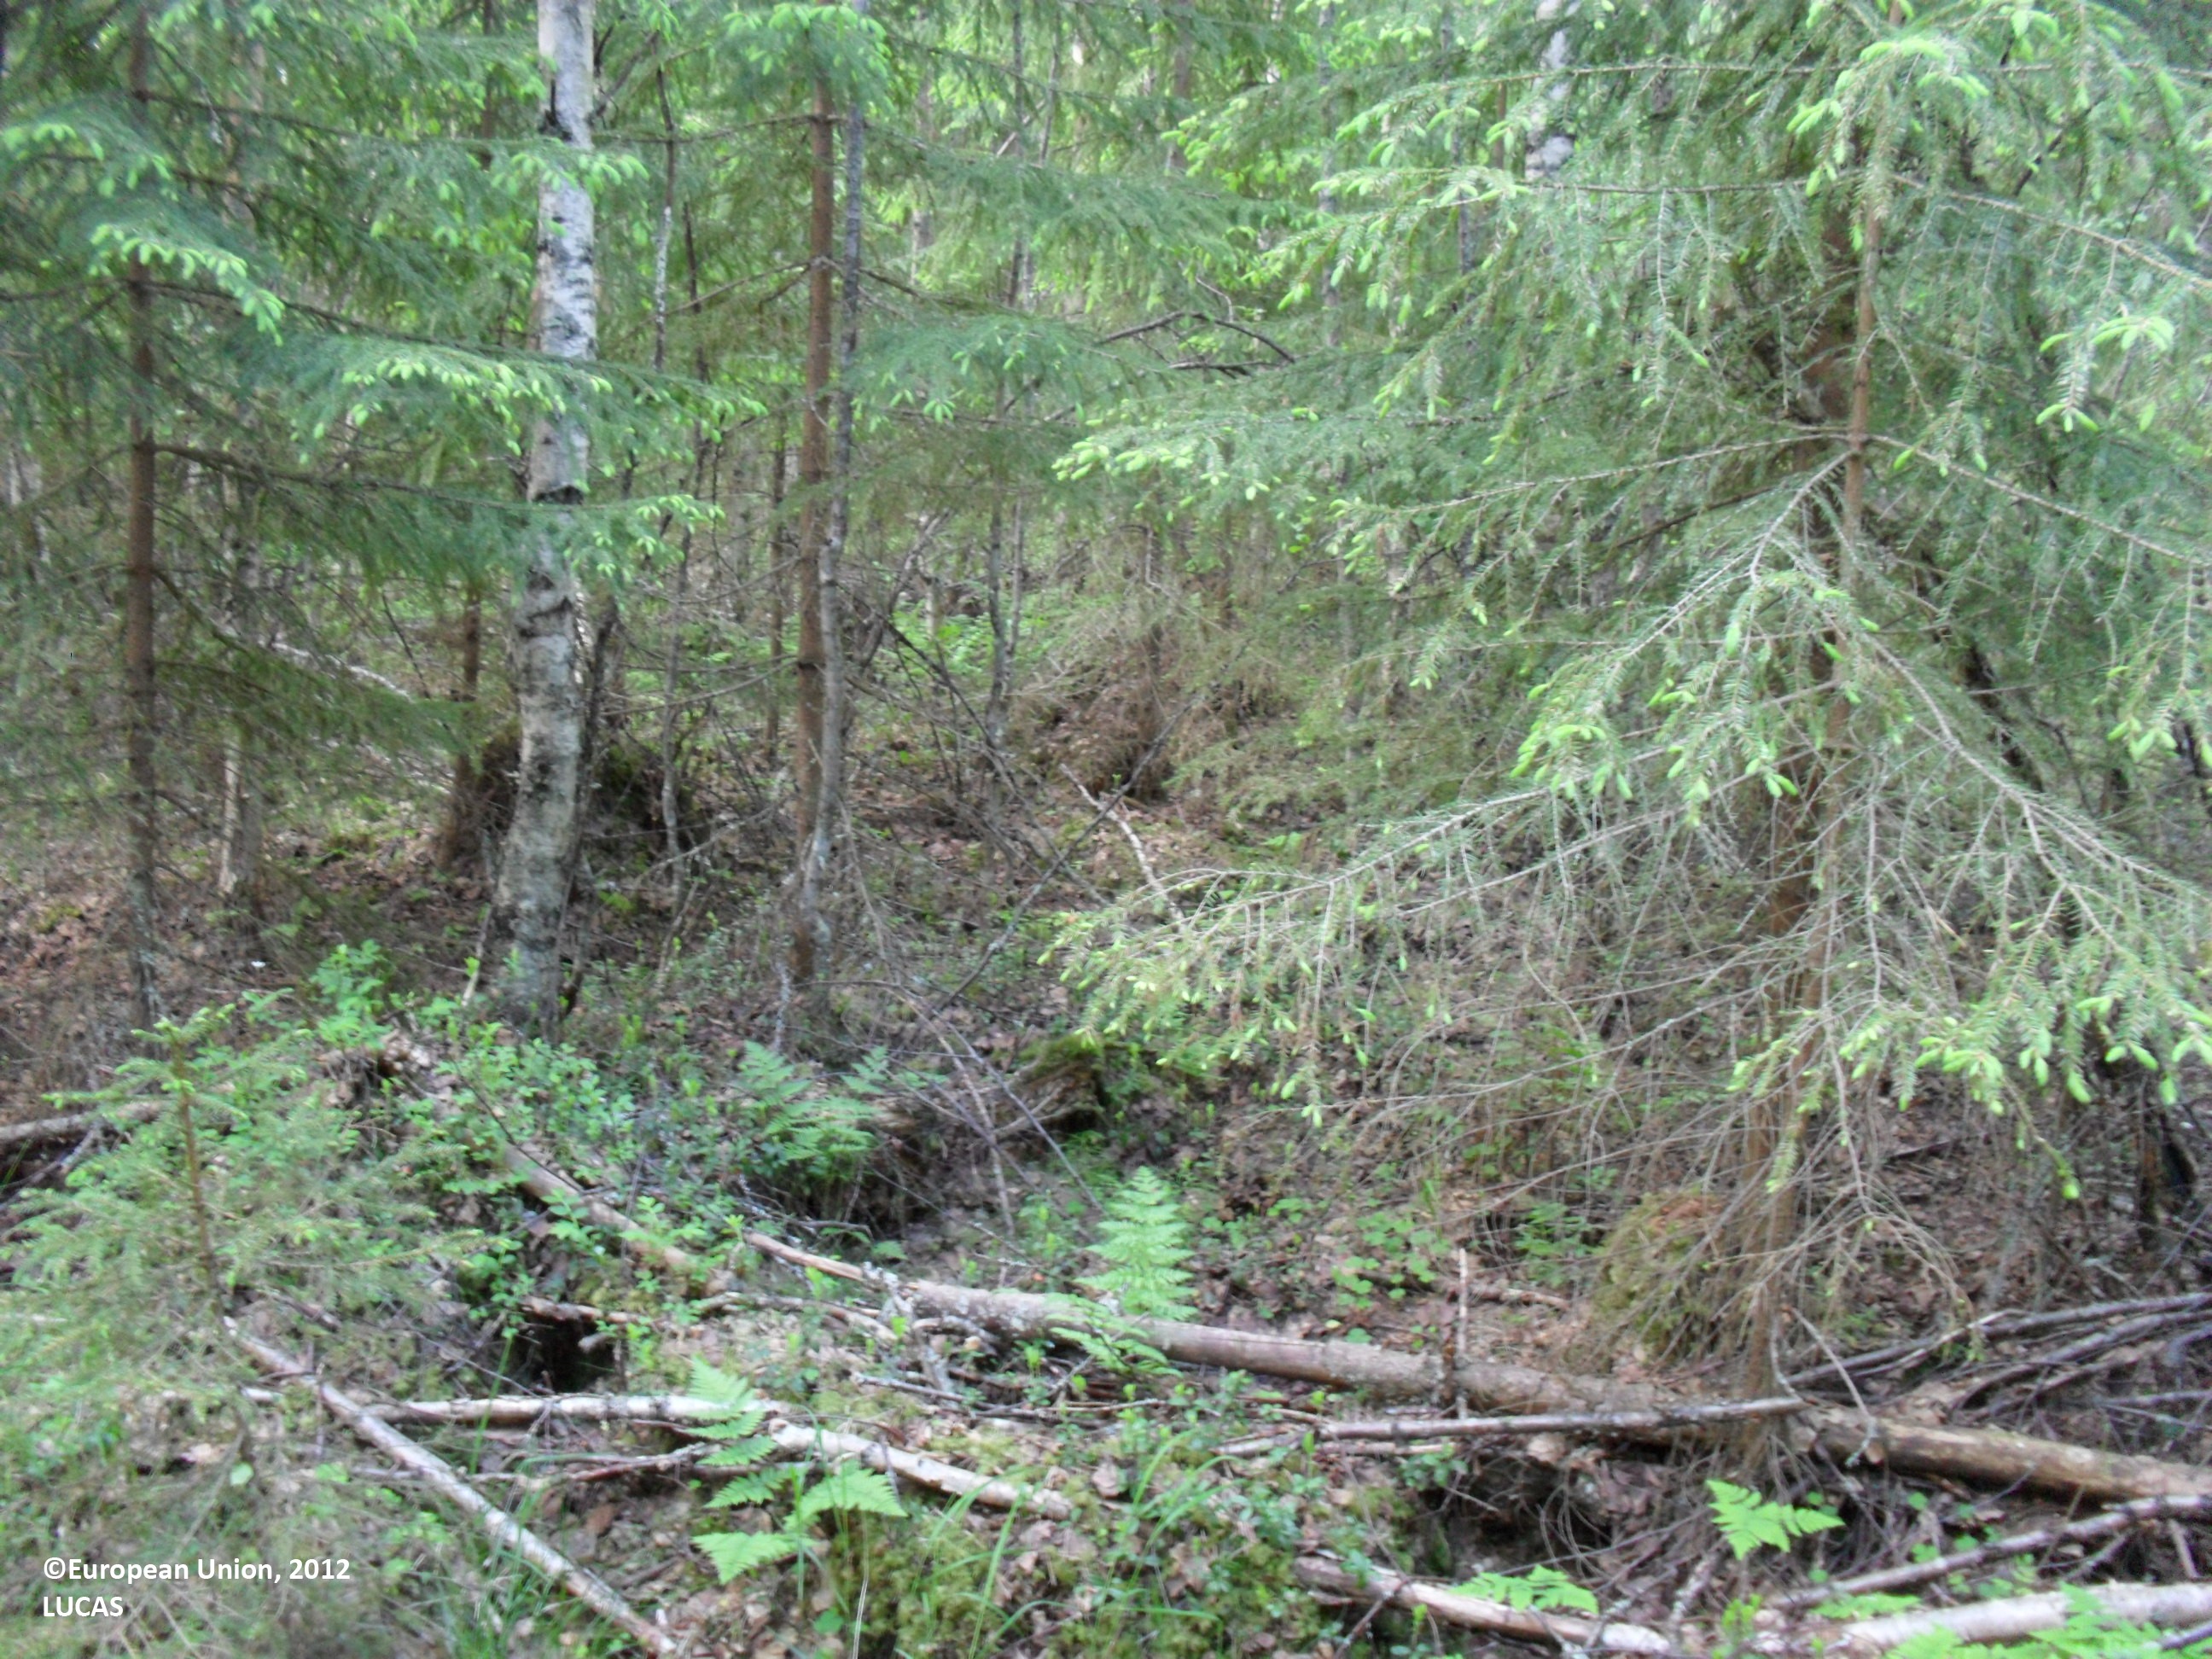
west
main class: Woodland
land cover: Other mixed woodland
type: boreal forest
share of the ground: > 75 %
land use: Forestry
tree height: > 5 m
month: June
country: FI
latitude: 62.7263
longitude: 23.3882
